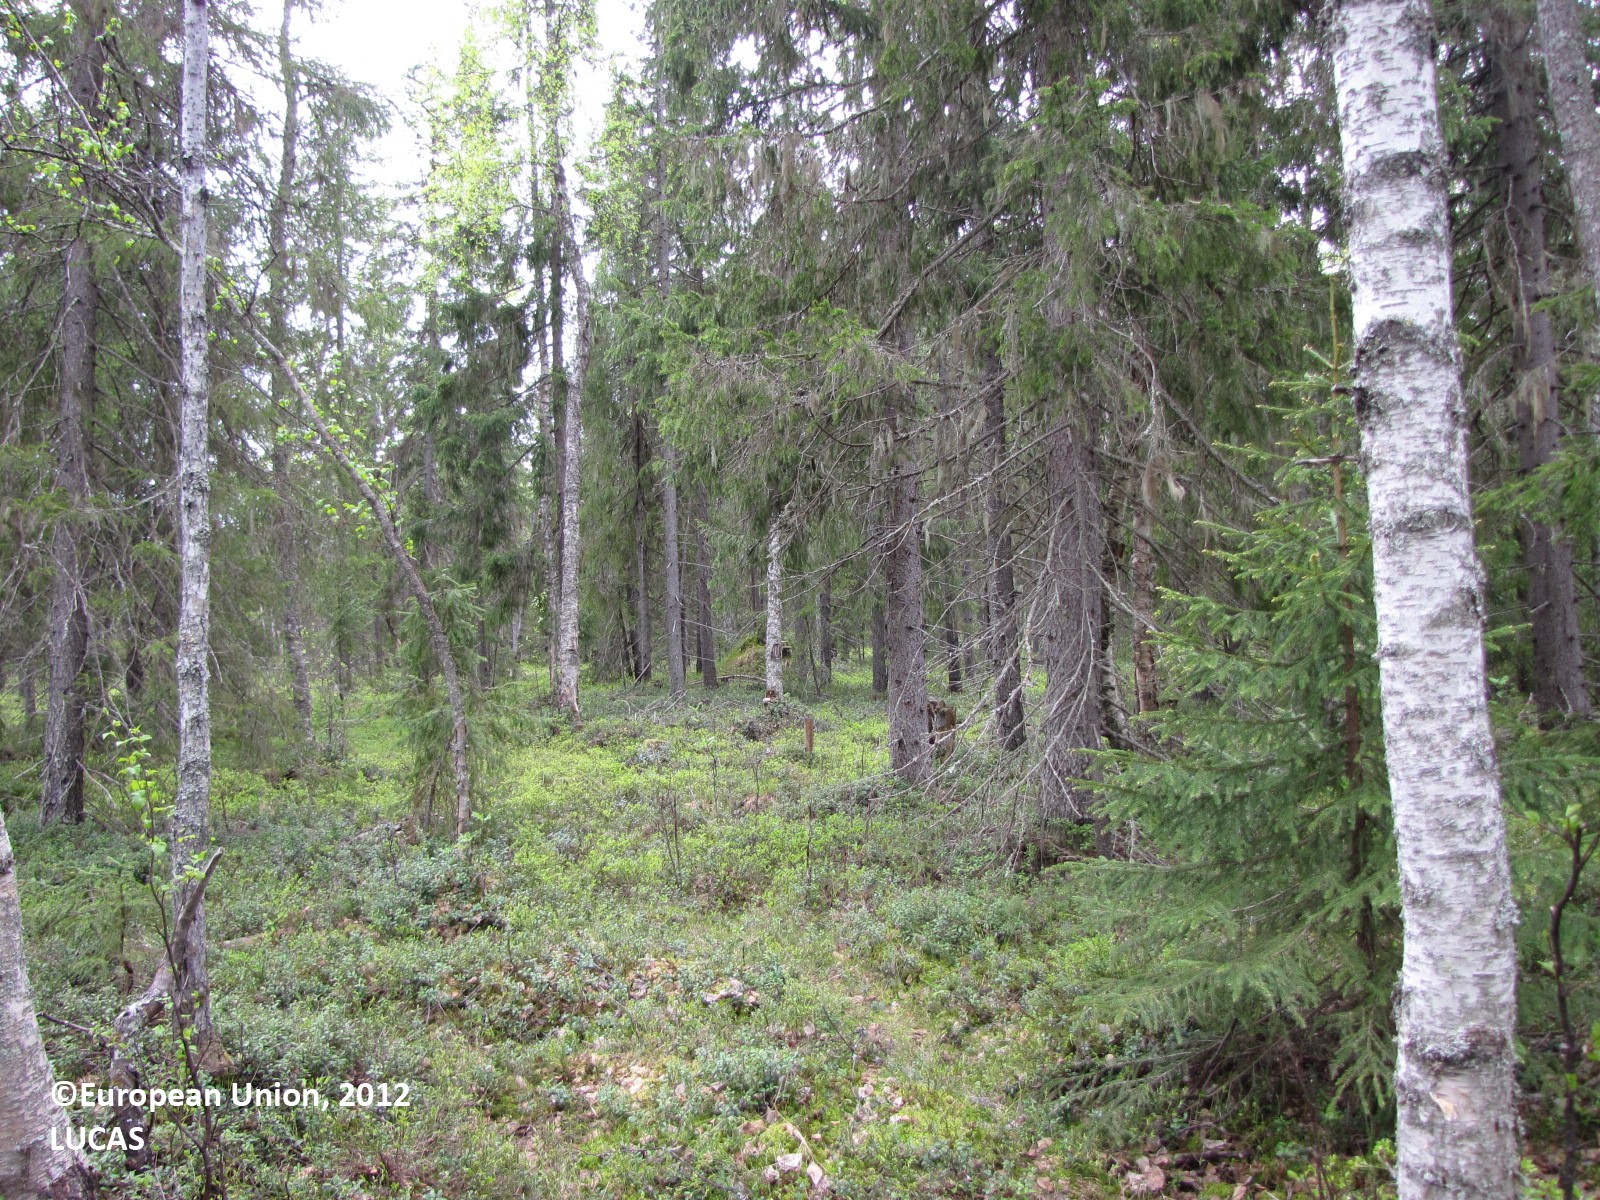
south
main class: Woodland
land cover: Spruce dominated mixed woodland
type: boreal forest
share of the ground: 50 - 75 %
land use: Forestry
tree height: > 5 m
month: June
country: FI
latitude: 65.8990
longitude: 24.5602
